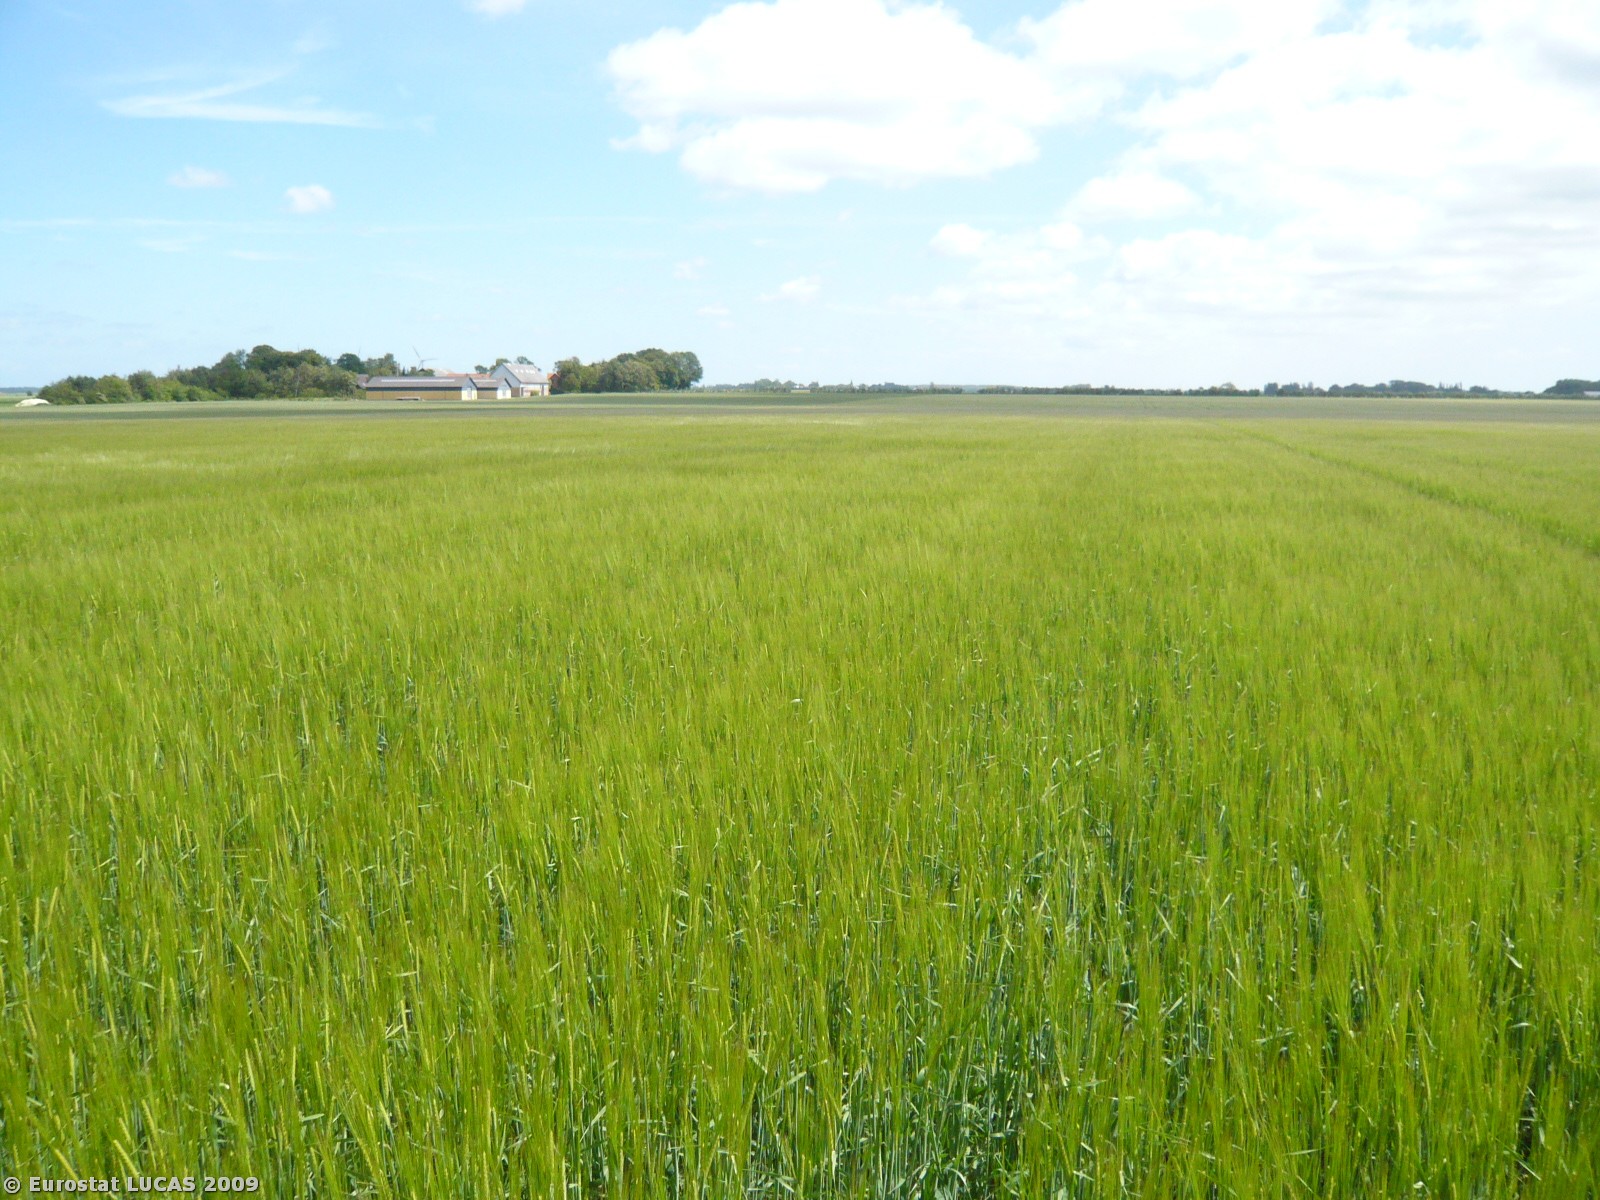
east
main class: Cropland
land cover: Barley
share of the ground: > 75 %
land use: Agriculture (excluding fallow land and kitchen gardens)
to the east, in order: Barley
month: June
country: DK
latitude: 54.7986
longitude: 11.1347
